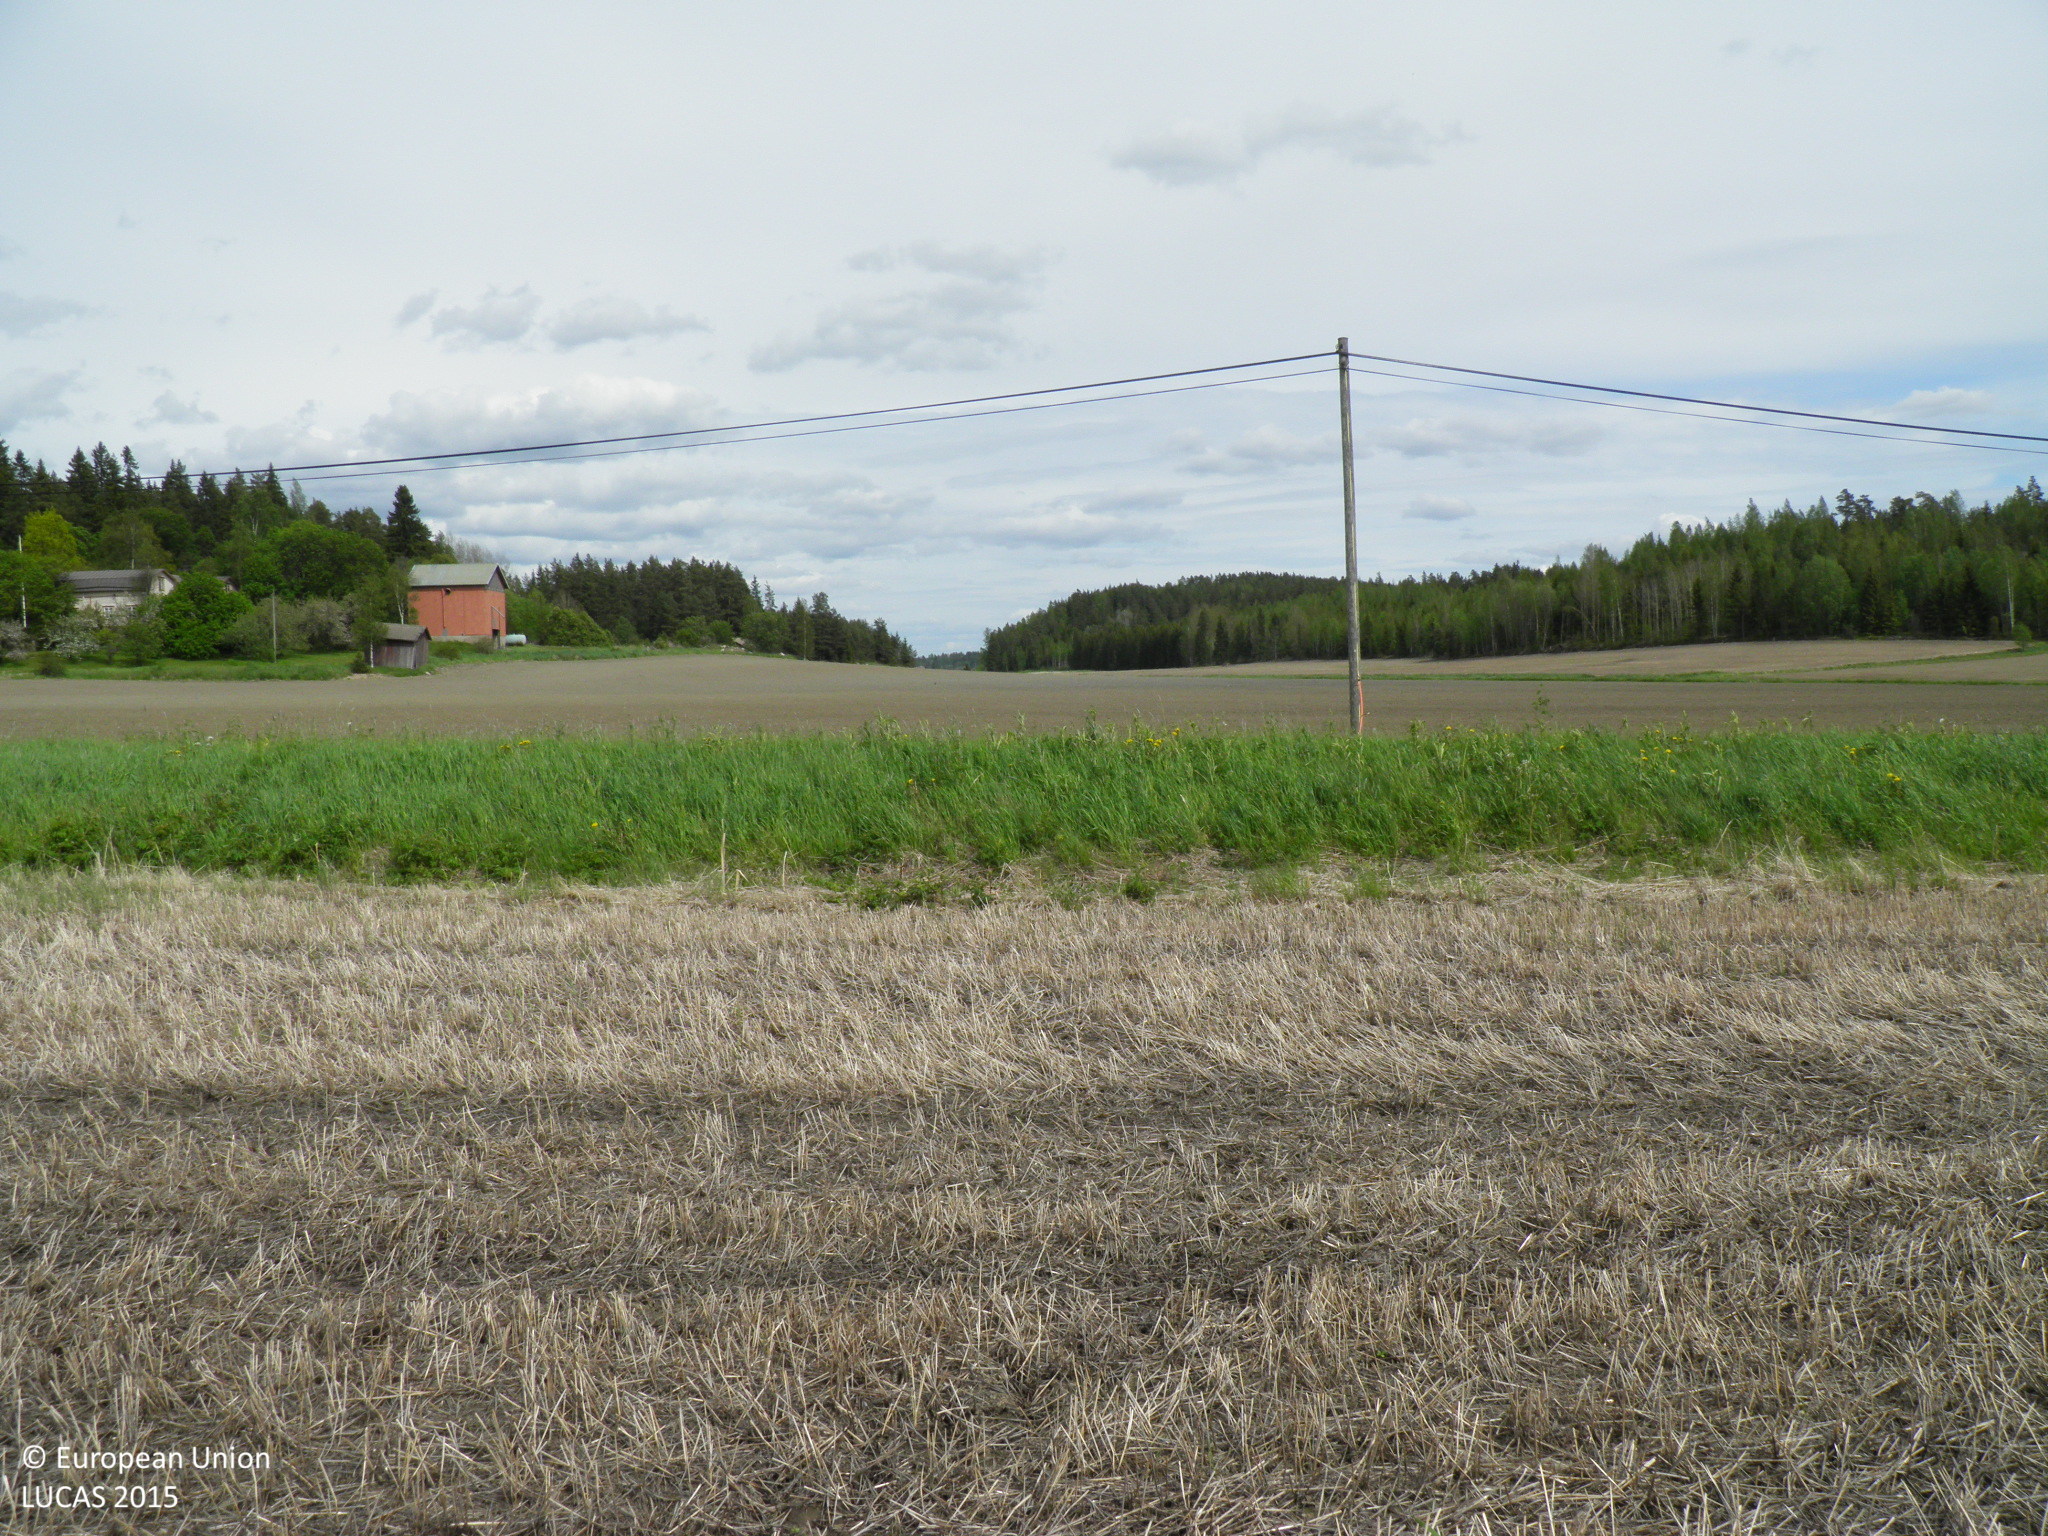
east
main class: Cropland
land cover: Common wheat
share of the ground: > 75 %
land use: Agriculture (excluding fallow land and kitchen gardens)
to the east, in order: Common wheat; Ditches and canals; Other bare soil; Ditches and canals; Grass margins; Paved roads, cycling and walking lanes; Grass margins; Ditches and canals; Grass margins; Common wheat; Grass margins; Ditches and canals; Grass margins; Common wheat
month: June
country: FI
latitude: 60.4678
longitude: 22.6401
